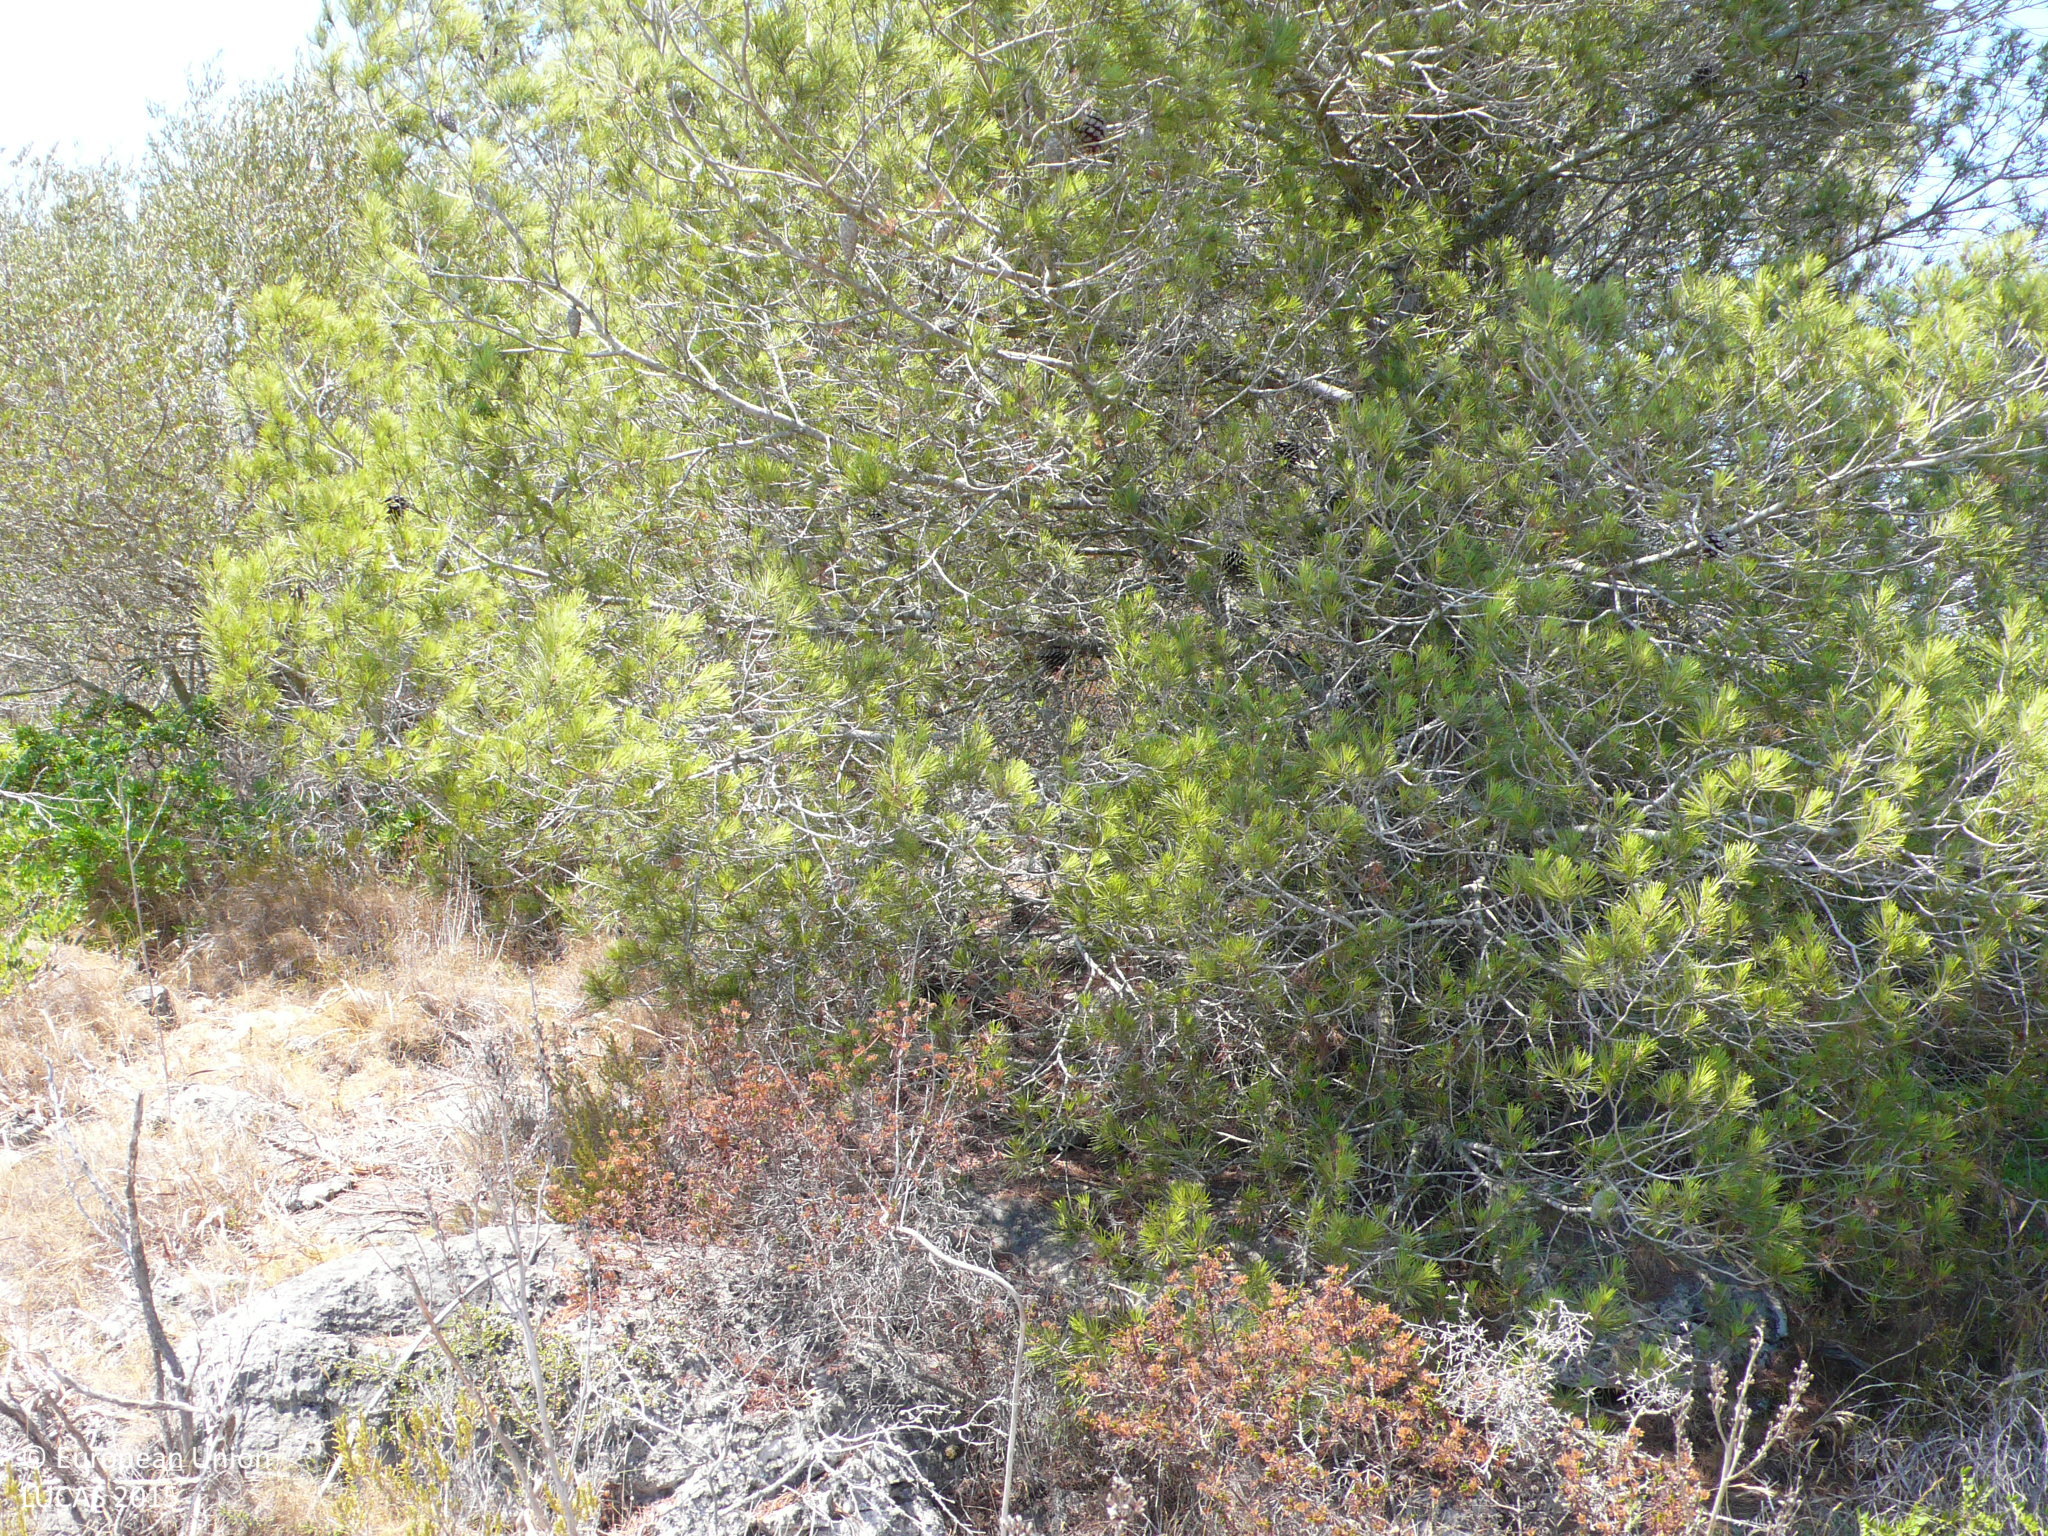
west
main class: Woodland
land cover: Pine dominated mixed woodland
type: coniferous forest of the mediterranean region
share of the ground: 50 - 75 %
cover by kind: shrubs 40 %, coniferous forest trees 35 %, broadleaved forest trees 15 %, consolidated bare surface 10 %
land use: Semi-natural and natural areas not in use
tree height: > 5 m
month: July
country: ES
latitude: 39.5276
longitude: 3.2711
